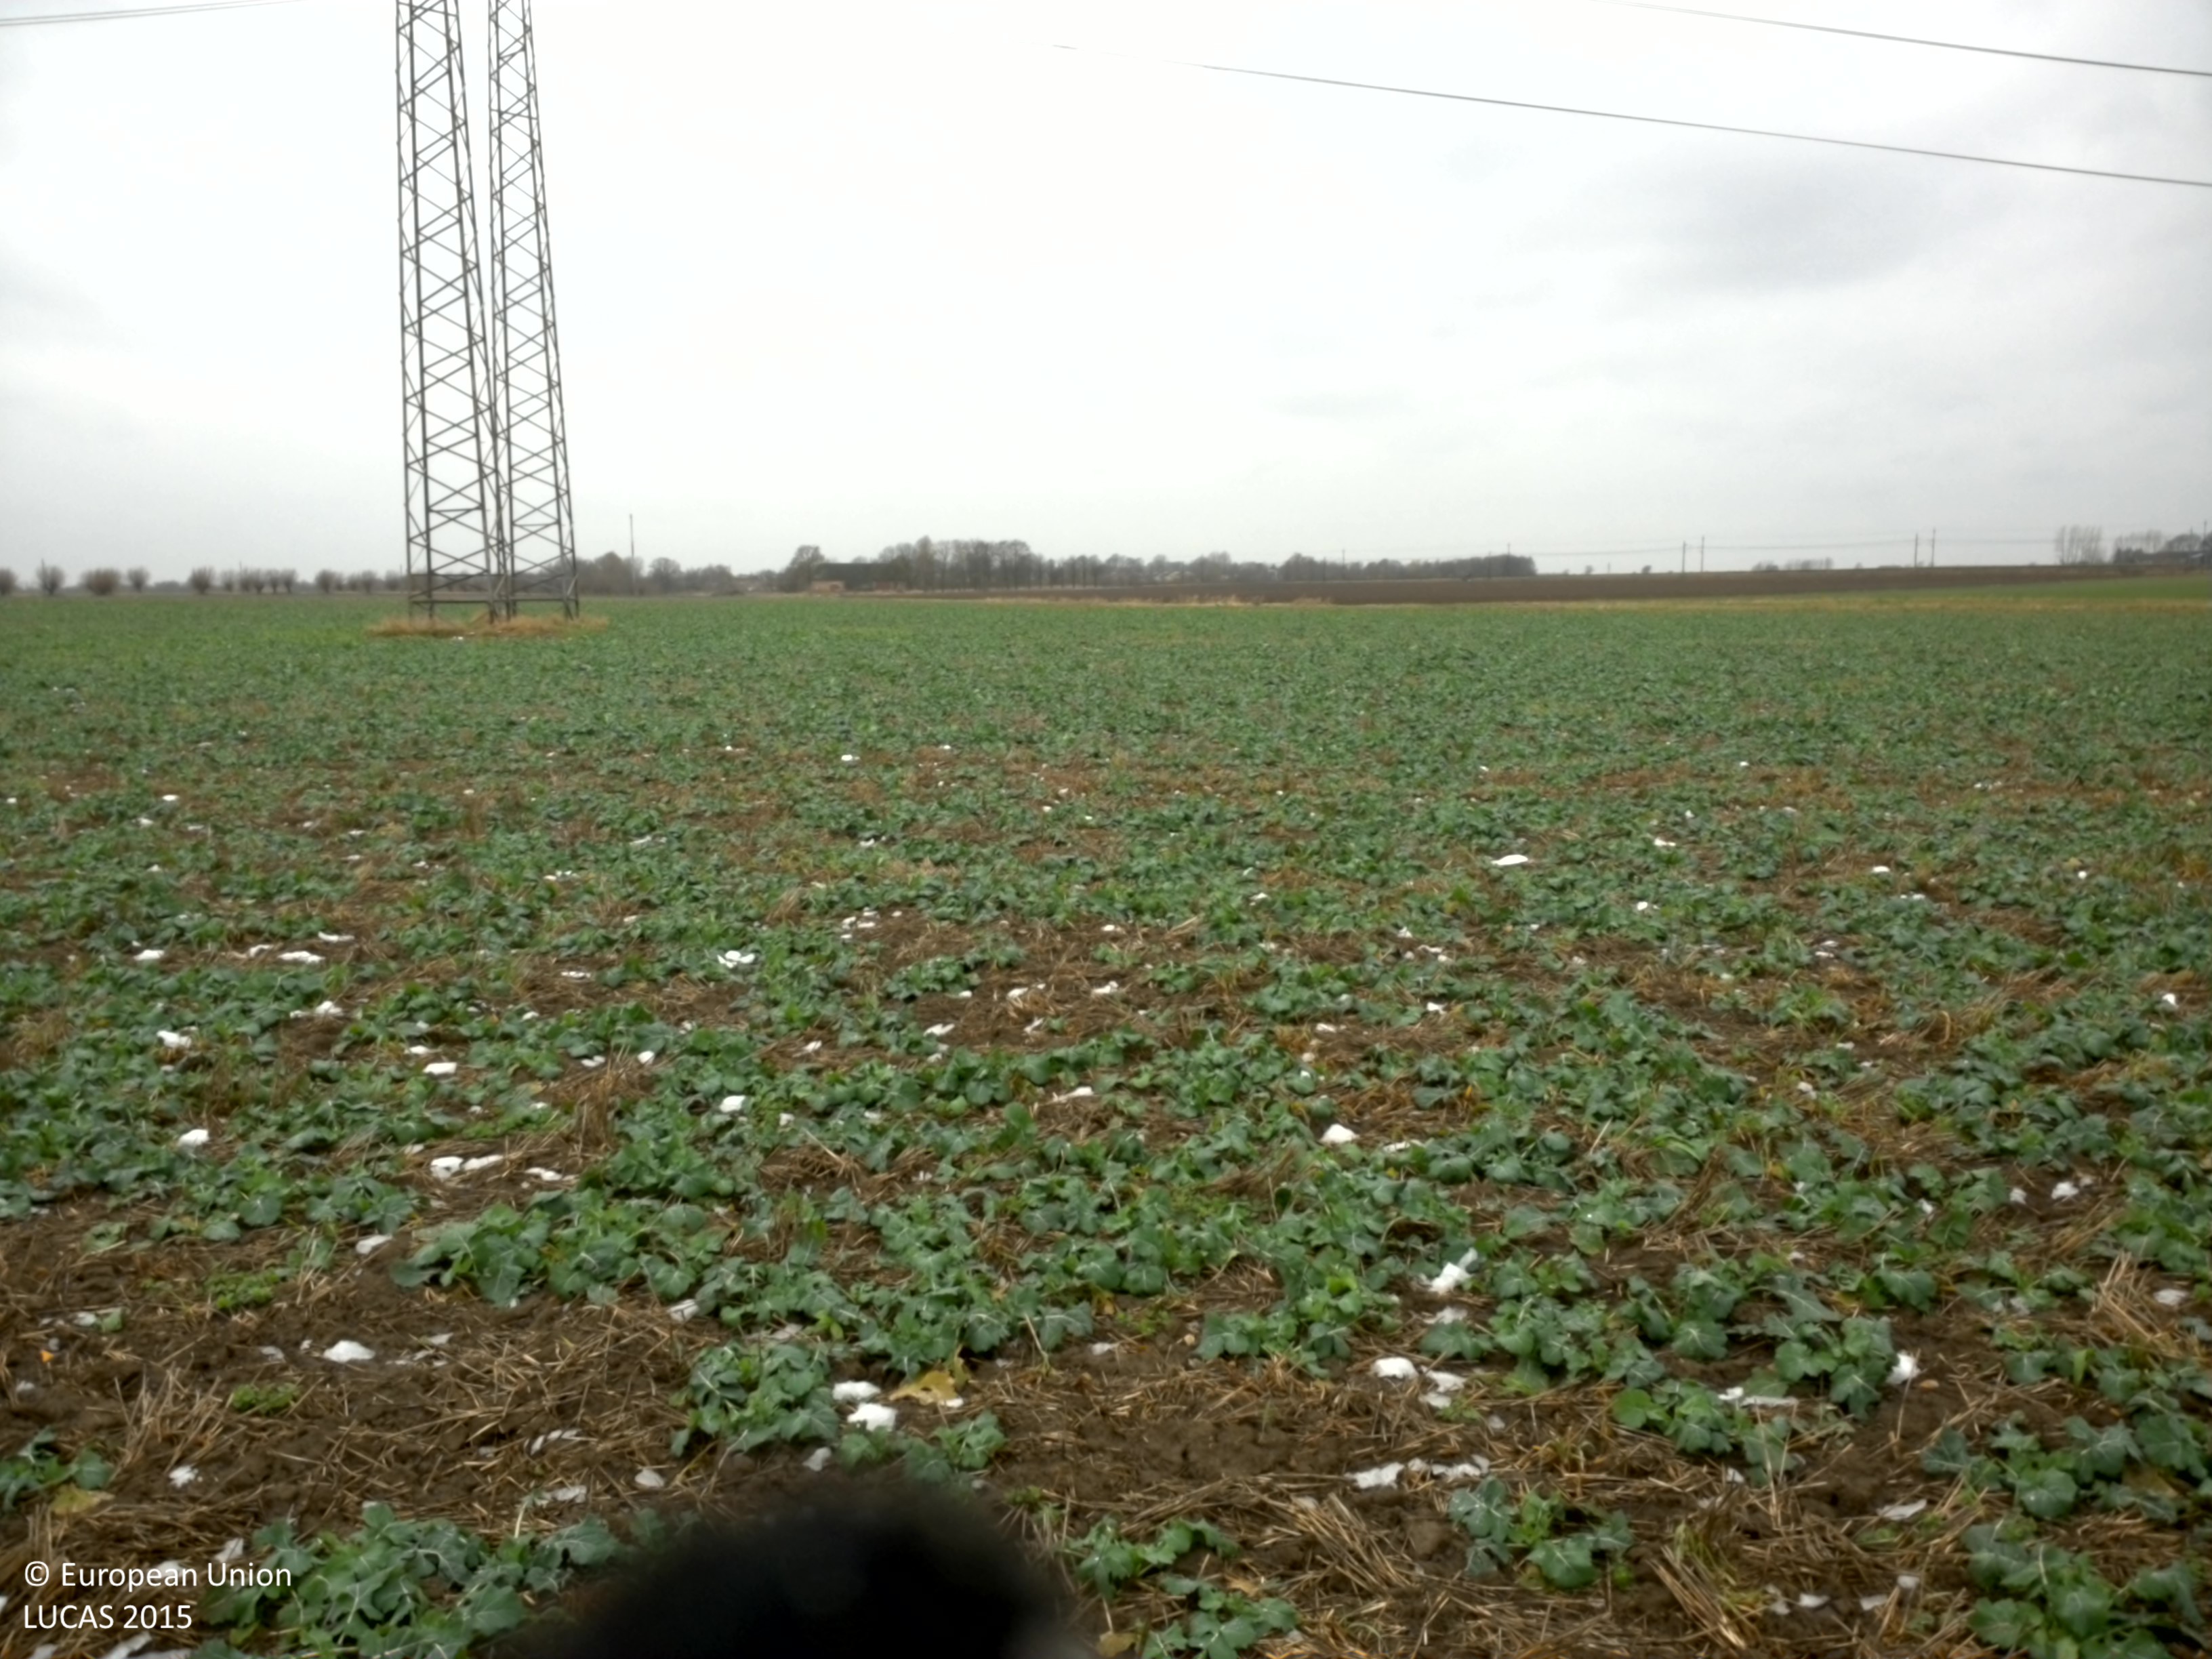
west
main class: Cropland
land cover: Rape and turnip rape
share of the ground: 25 - 50 %
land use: Agriculture (excluding fallow land and kitchen gardens)
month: November
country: SE
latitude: 55.6639
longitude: 13.1296
